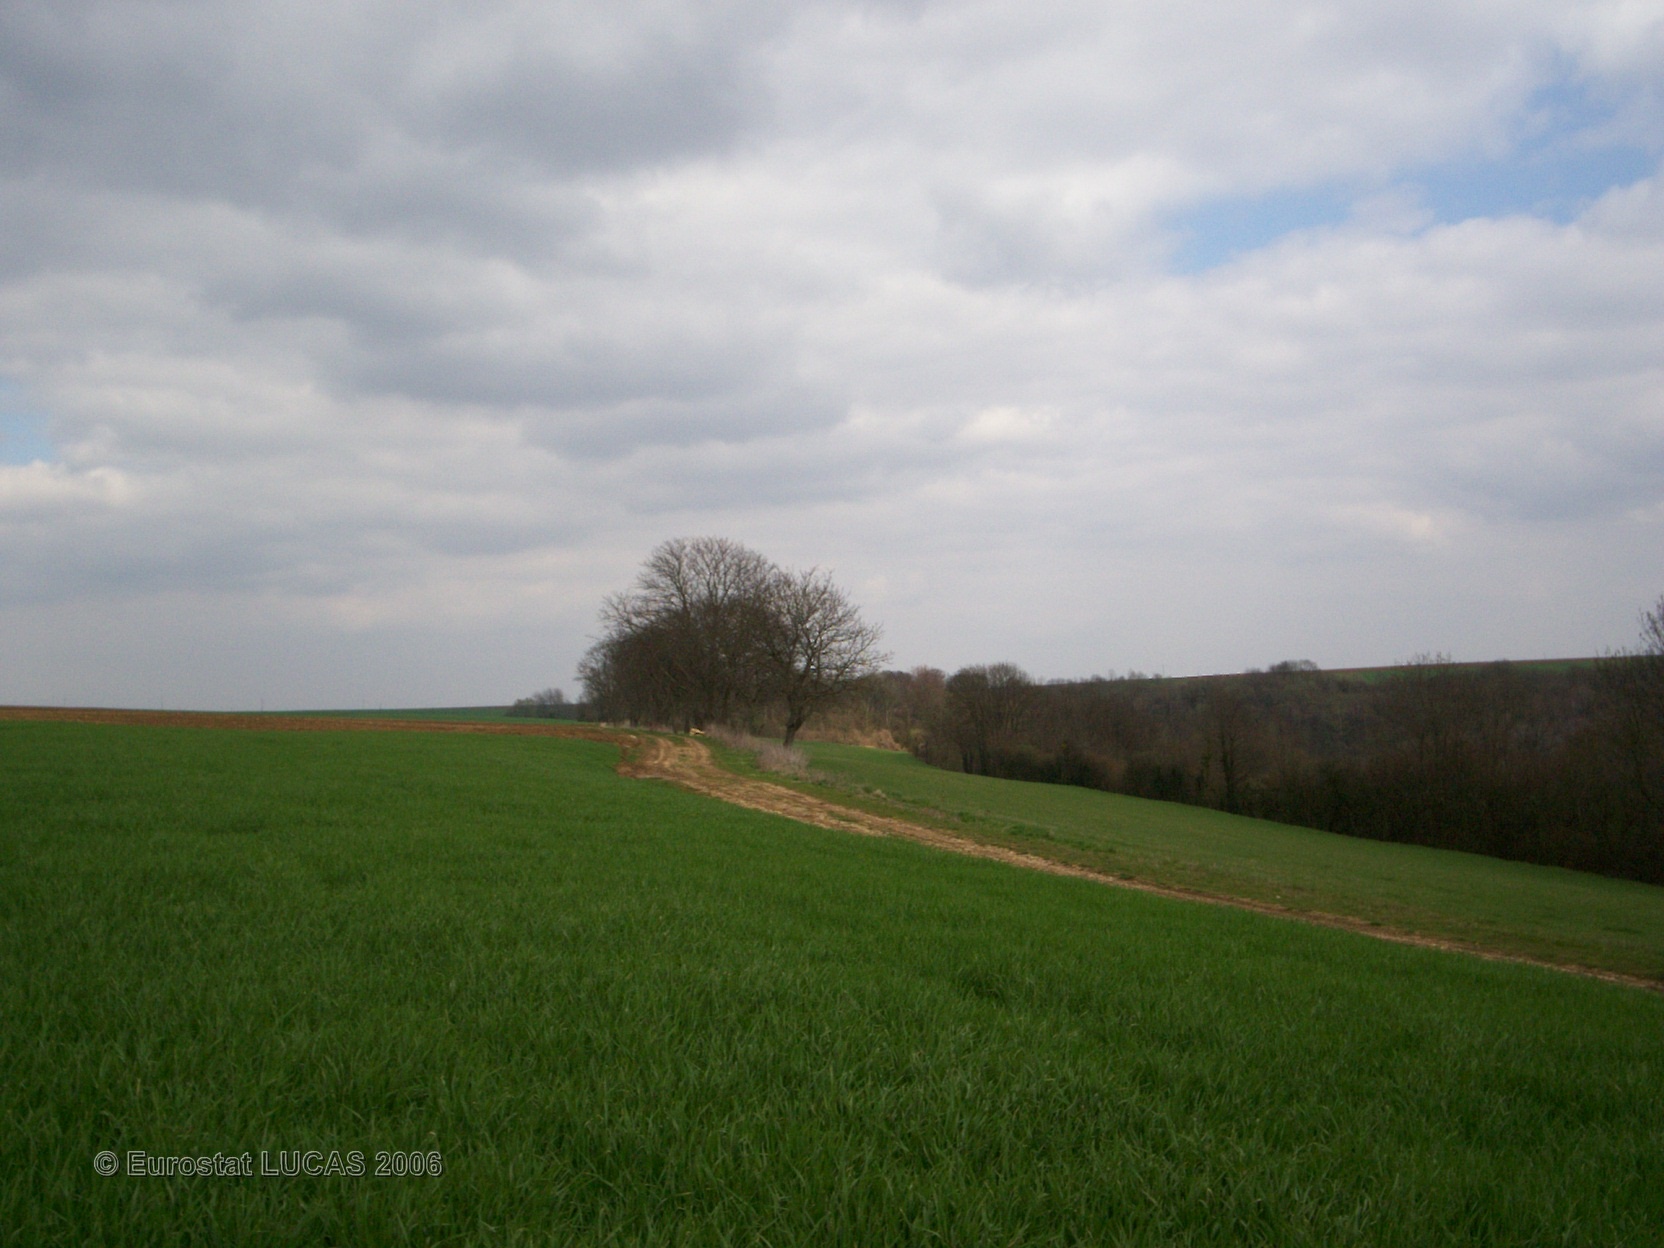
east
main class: Cropland
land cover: Common wheat
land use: Agriculture (excluding fallow land and kitchen gardens)
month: April
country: FR
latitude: 49.4323
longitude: 3.6921
